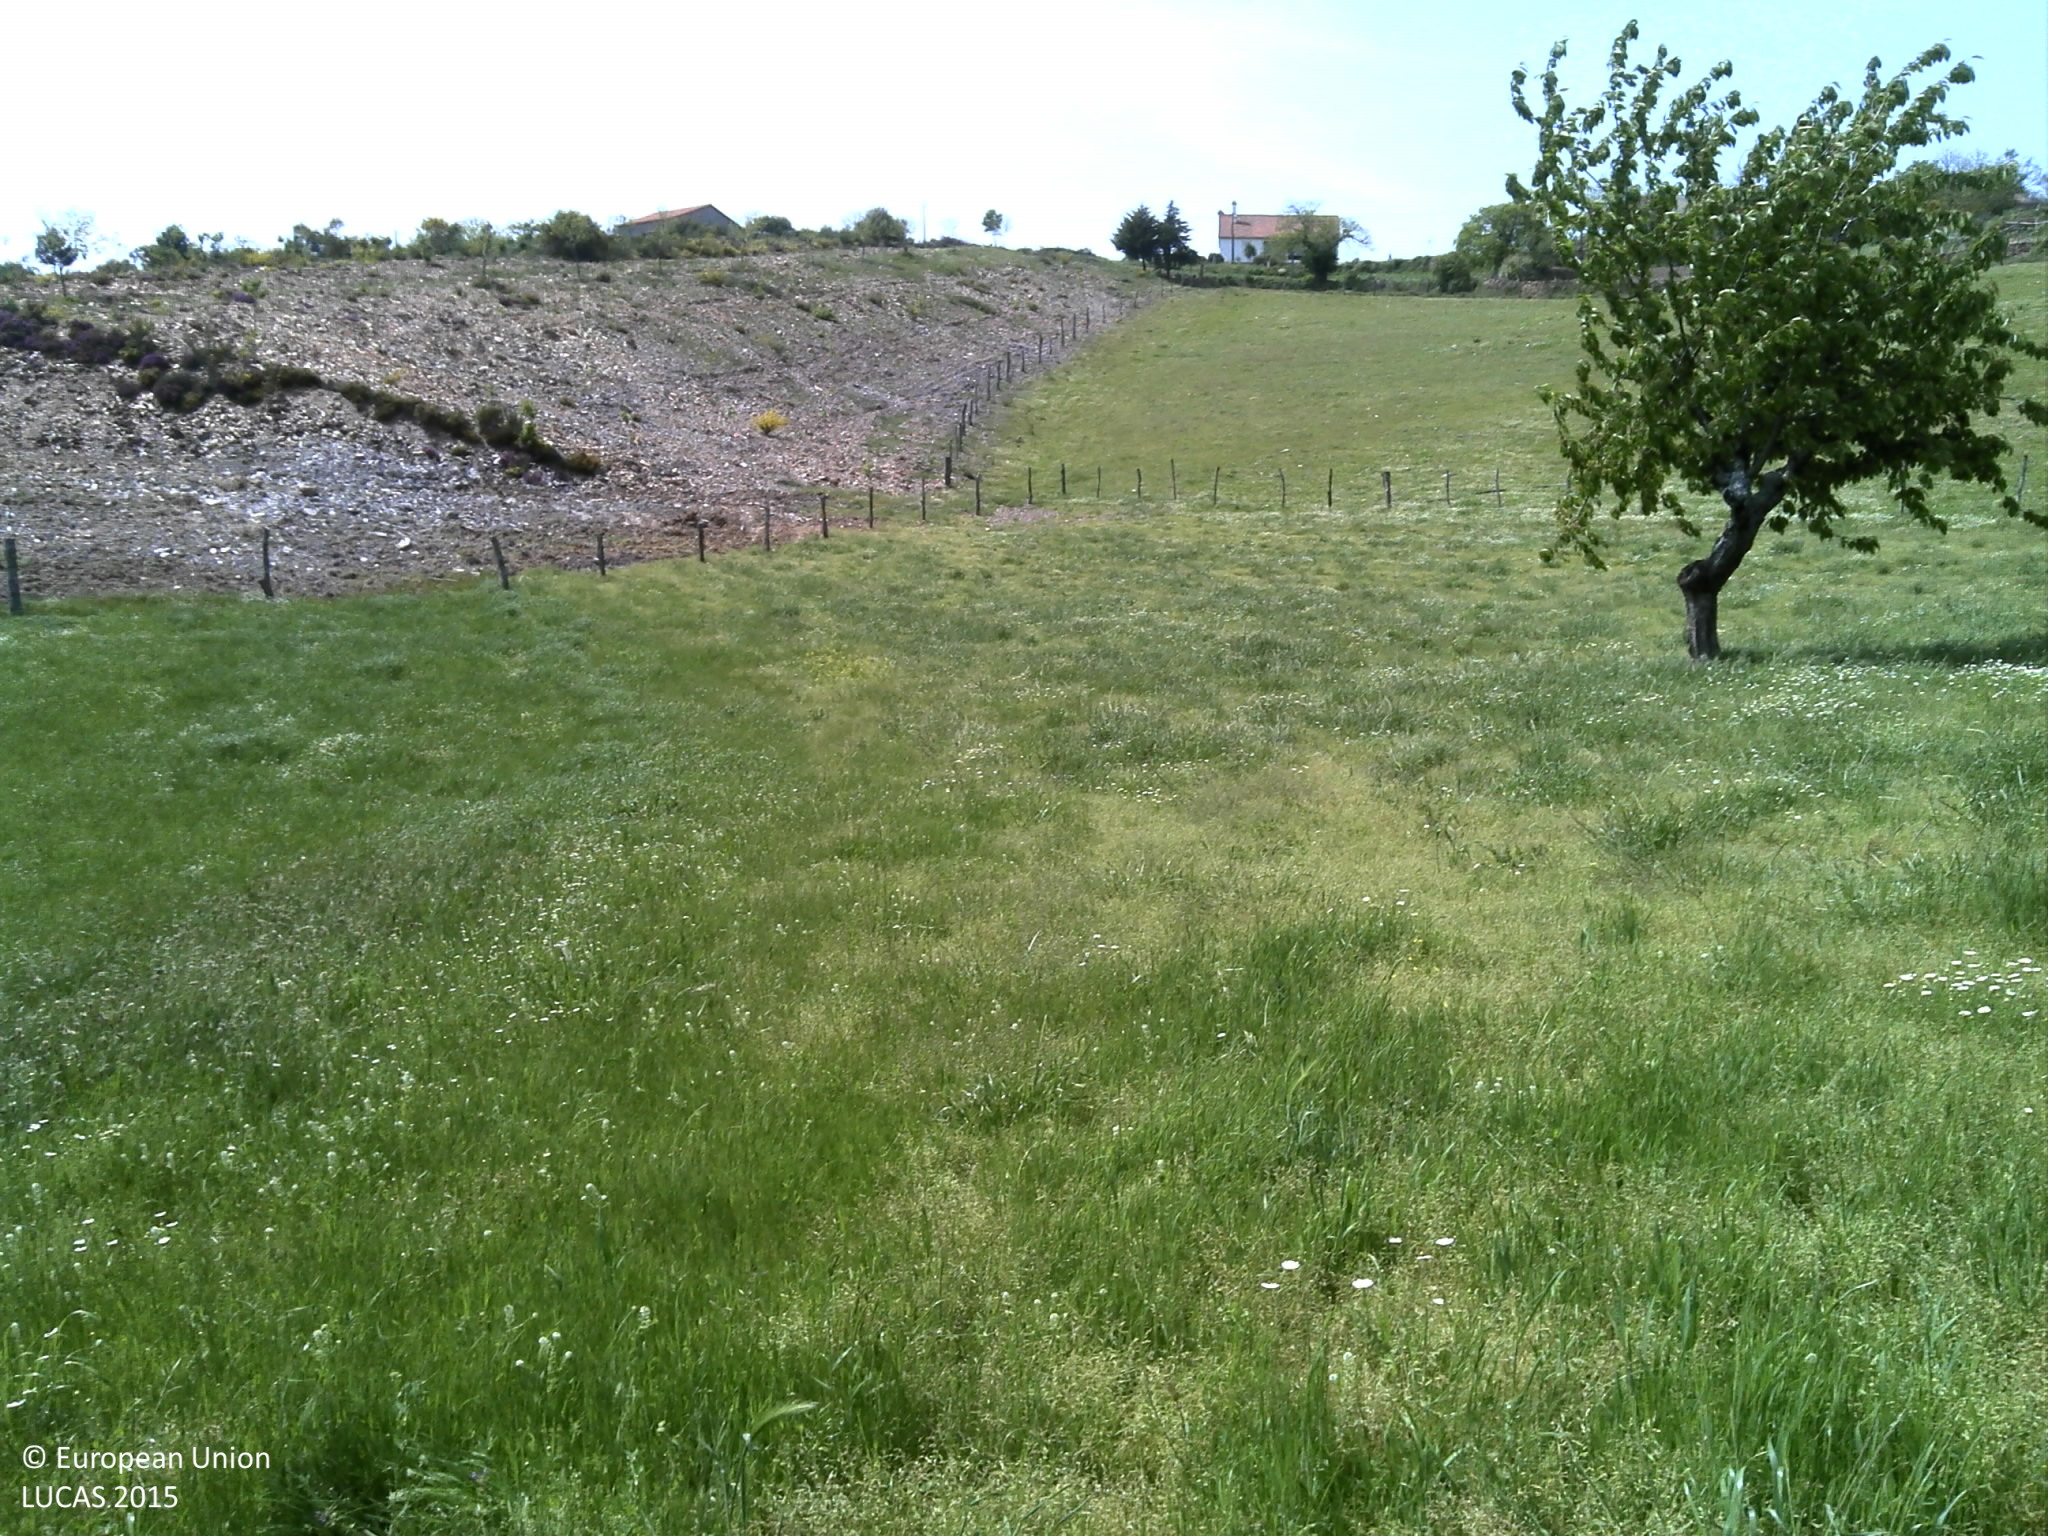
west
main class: Grassland
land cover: Spontaneously vegetated surfaces
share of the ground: > 75 %
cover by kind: herbaceous plants 95 %, unconsolidated bare surface 5 %
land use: Agriculture (excluding fallow land and kitchen gardens)
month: May
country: PT
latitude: 41.7623
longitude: -6.9691
